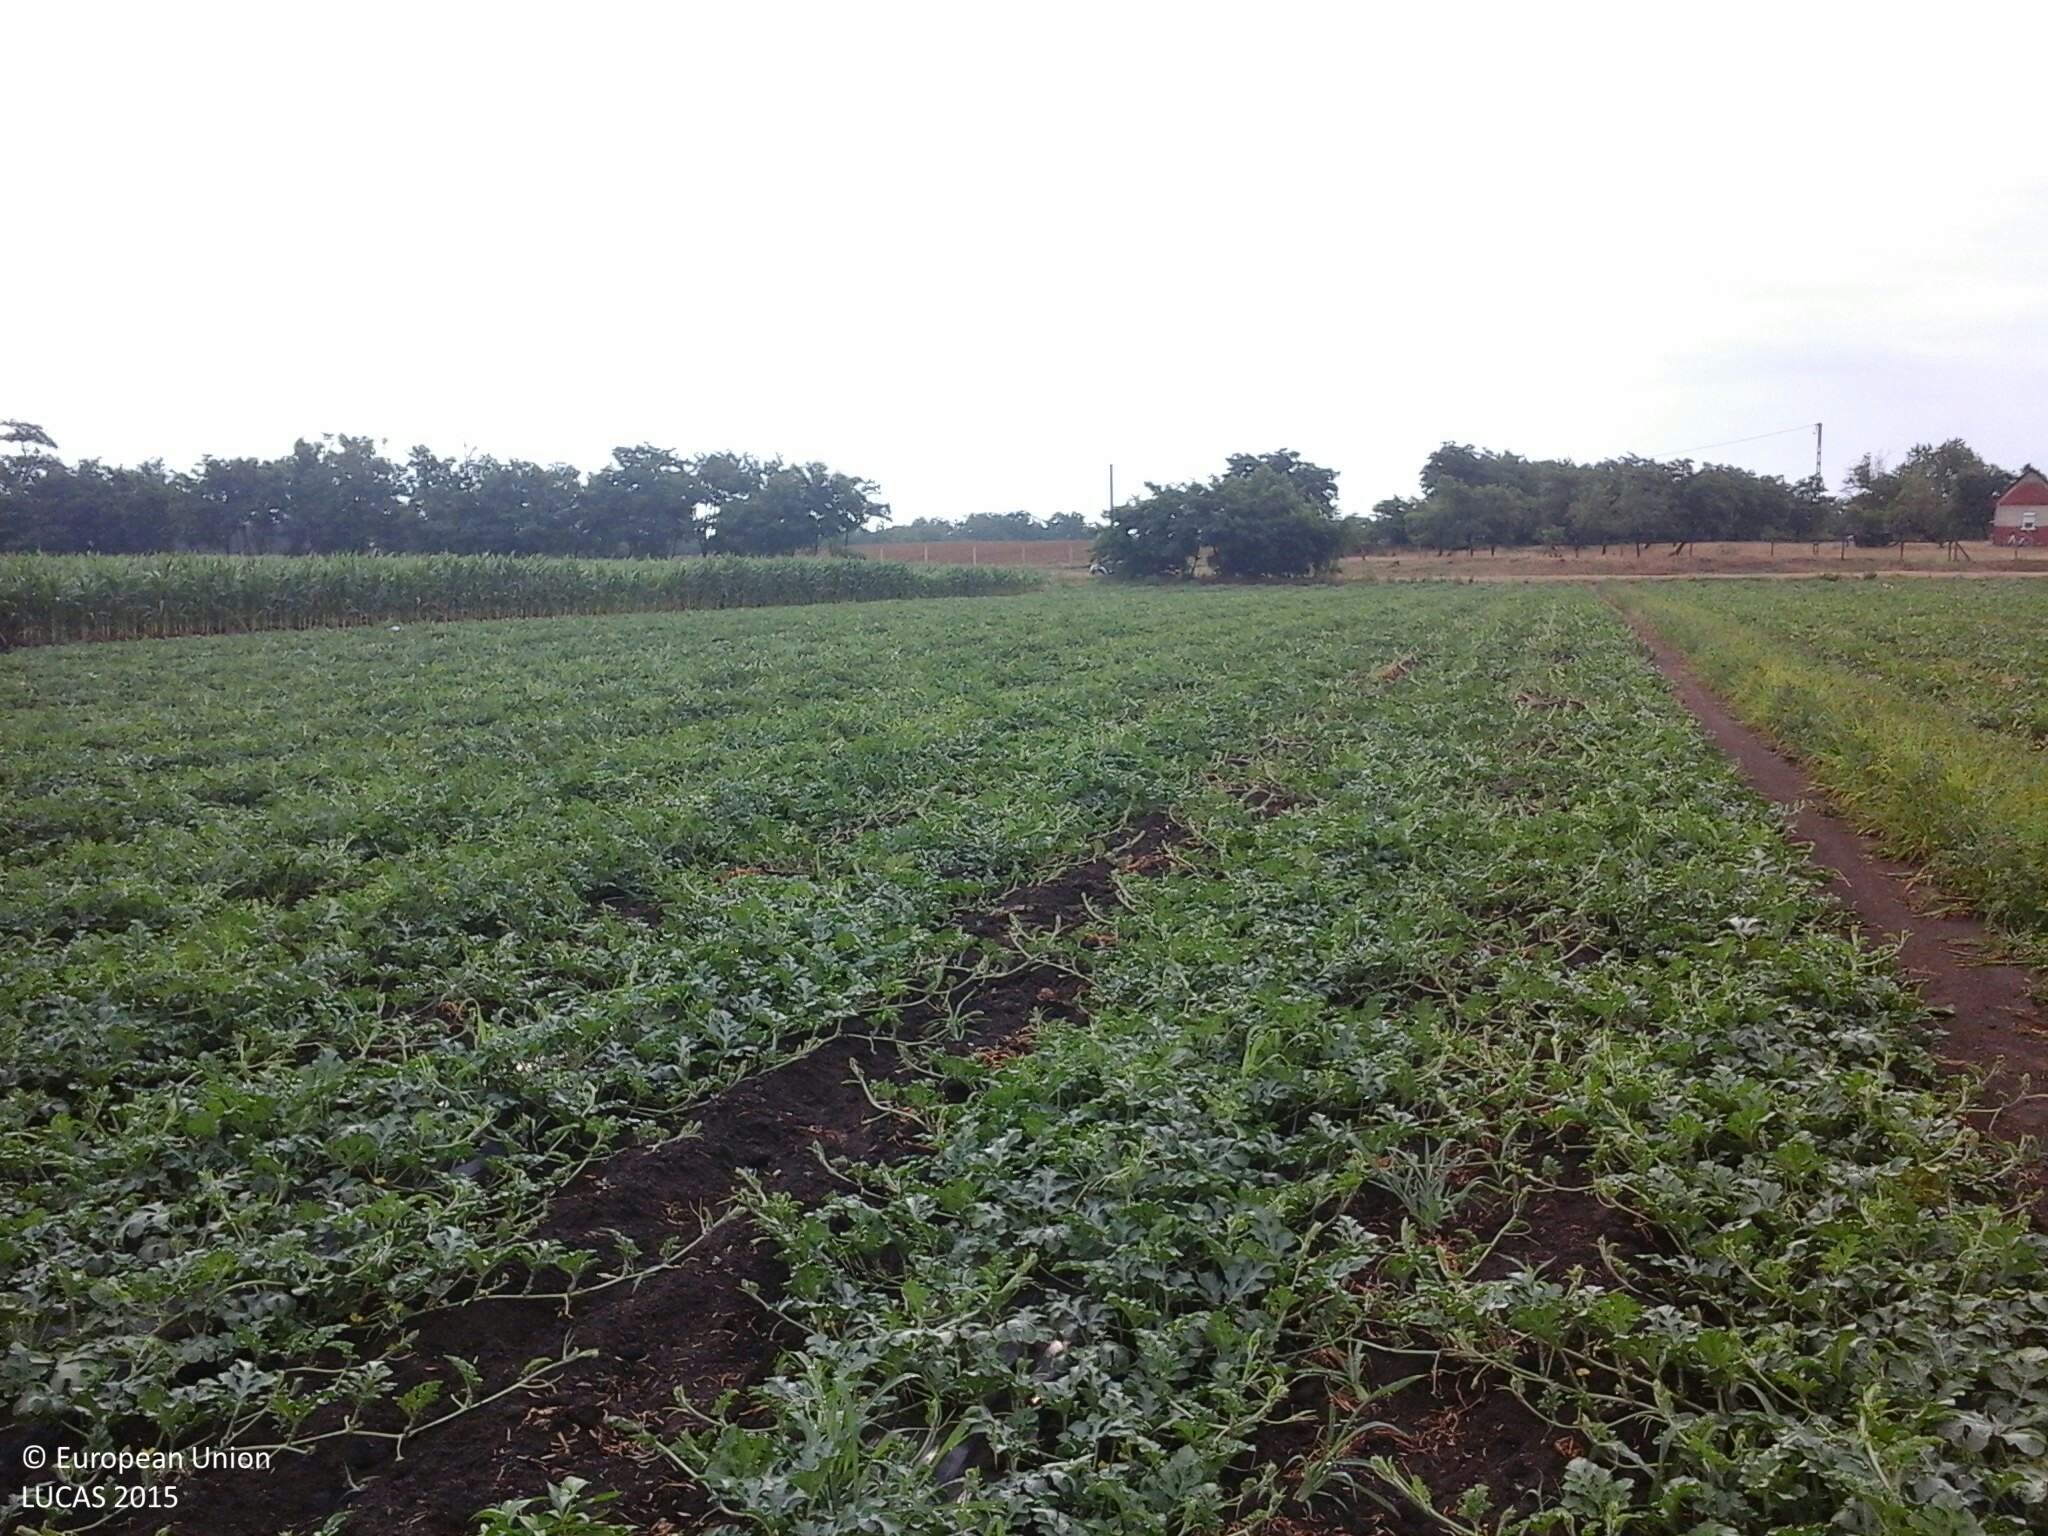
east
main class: Cropland
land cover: Other fresh vegetables
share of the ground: 50 - 75 %
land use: Agriculture (excluding fallow land and kitchen gardens)
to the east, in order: Other fresh vegetables; Grass margins; Ditches and canals; Grass margins; Shrubland without tree cover; Paved roads, cycling and walking lanes; Grass margins; Ditches and canals; Grass margins; Electric lines; Fences; Other fresh vegetables
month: July
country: HU
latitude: 47.8133
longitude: 21.8952
